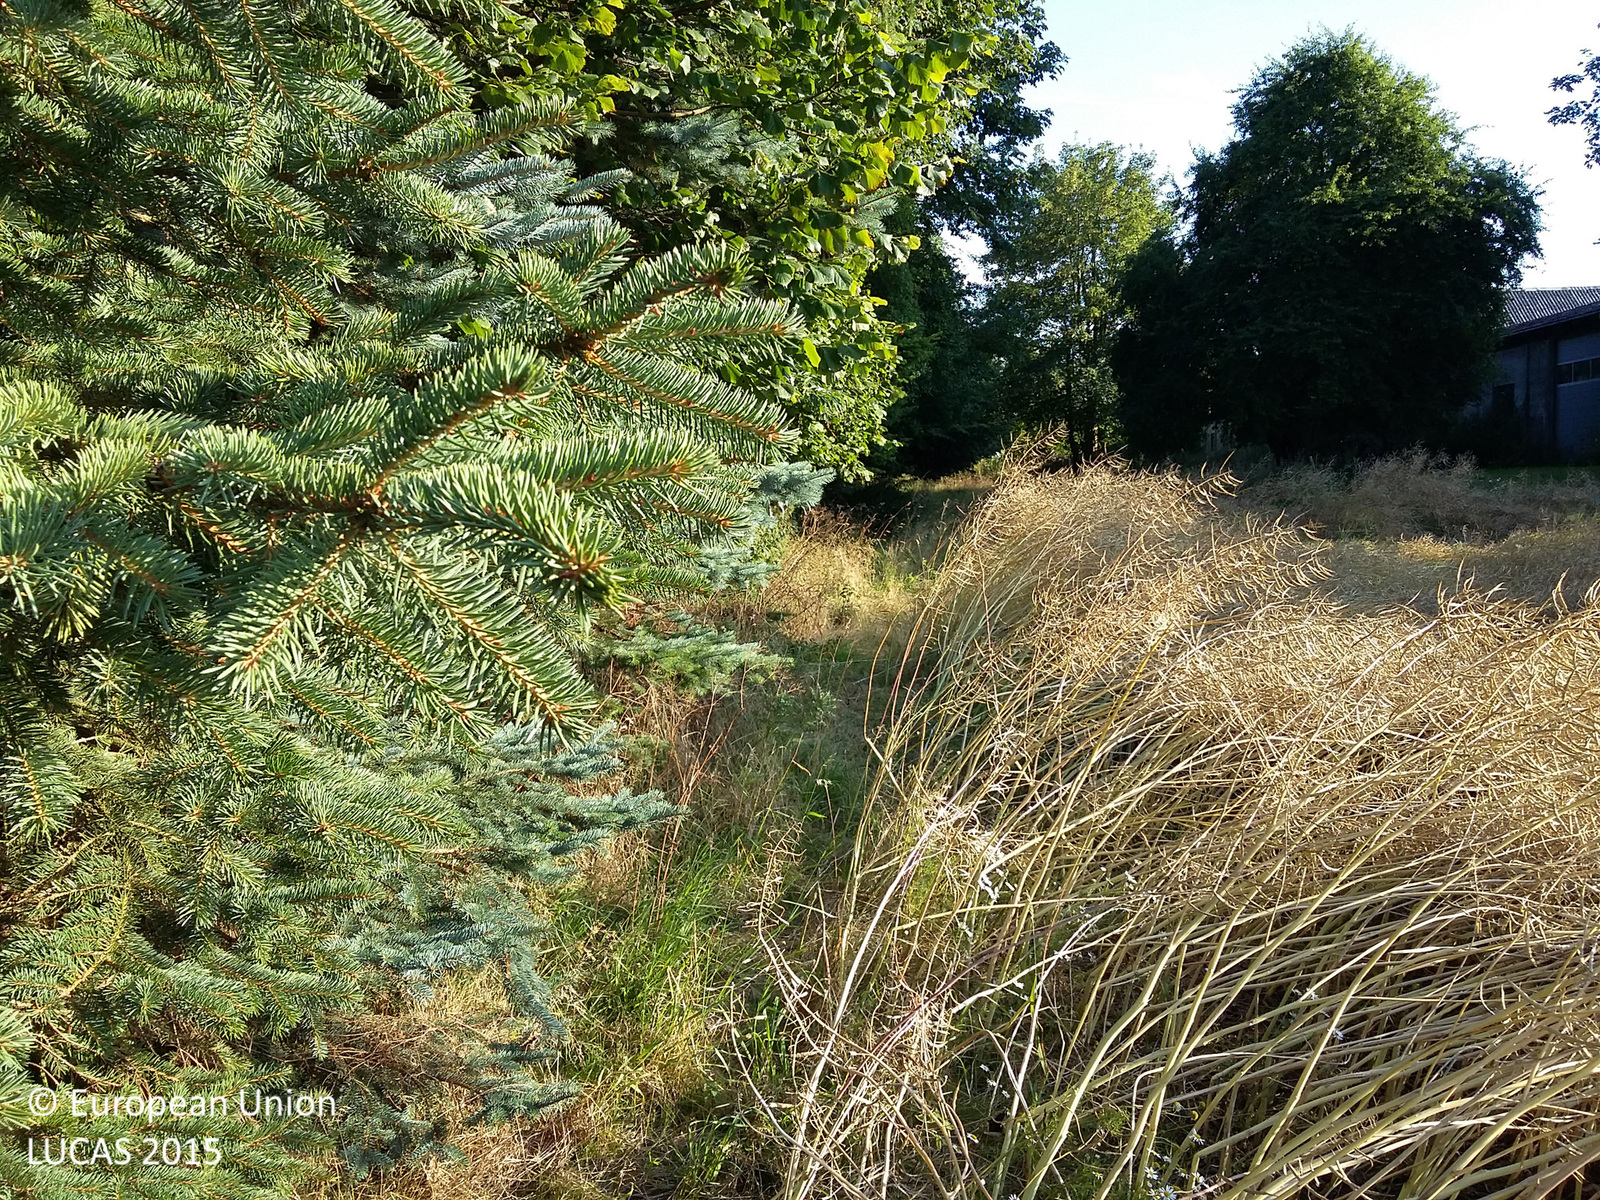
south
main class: Cropland
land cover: Rape and turnip rape
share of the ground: > 75 %
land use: Agriculture (excluding fallow land and kitchen gardens)
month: August
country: DK
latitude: 55.3465
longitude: 11.9066
